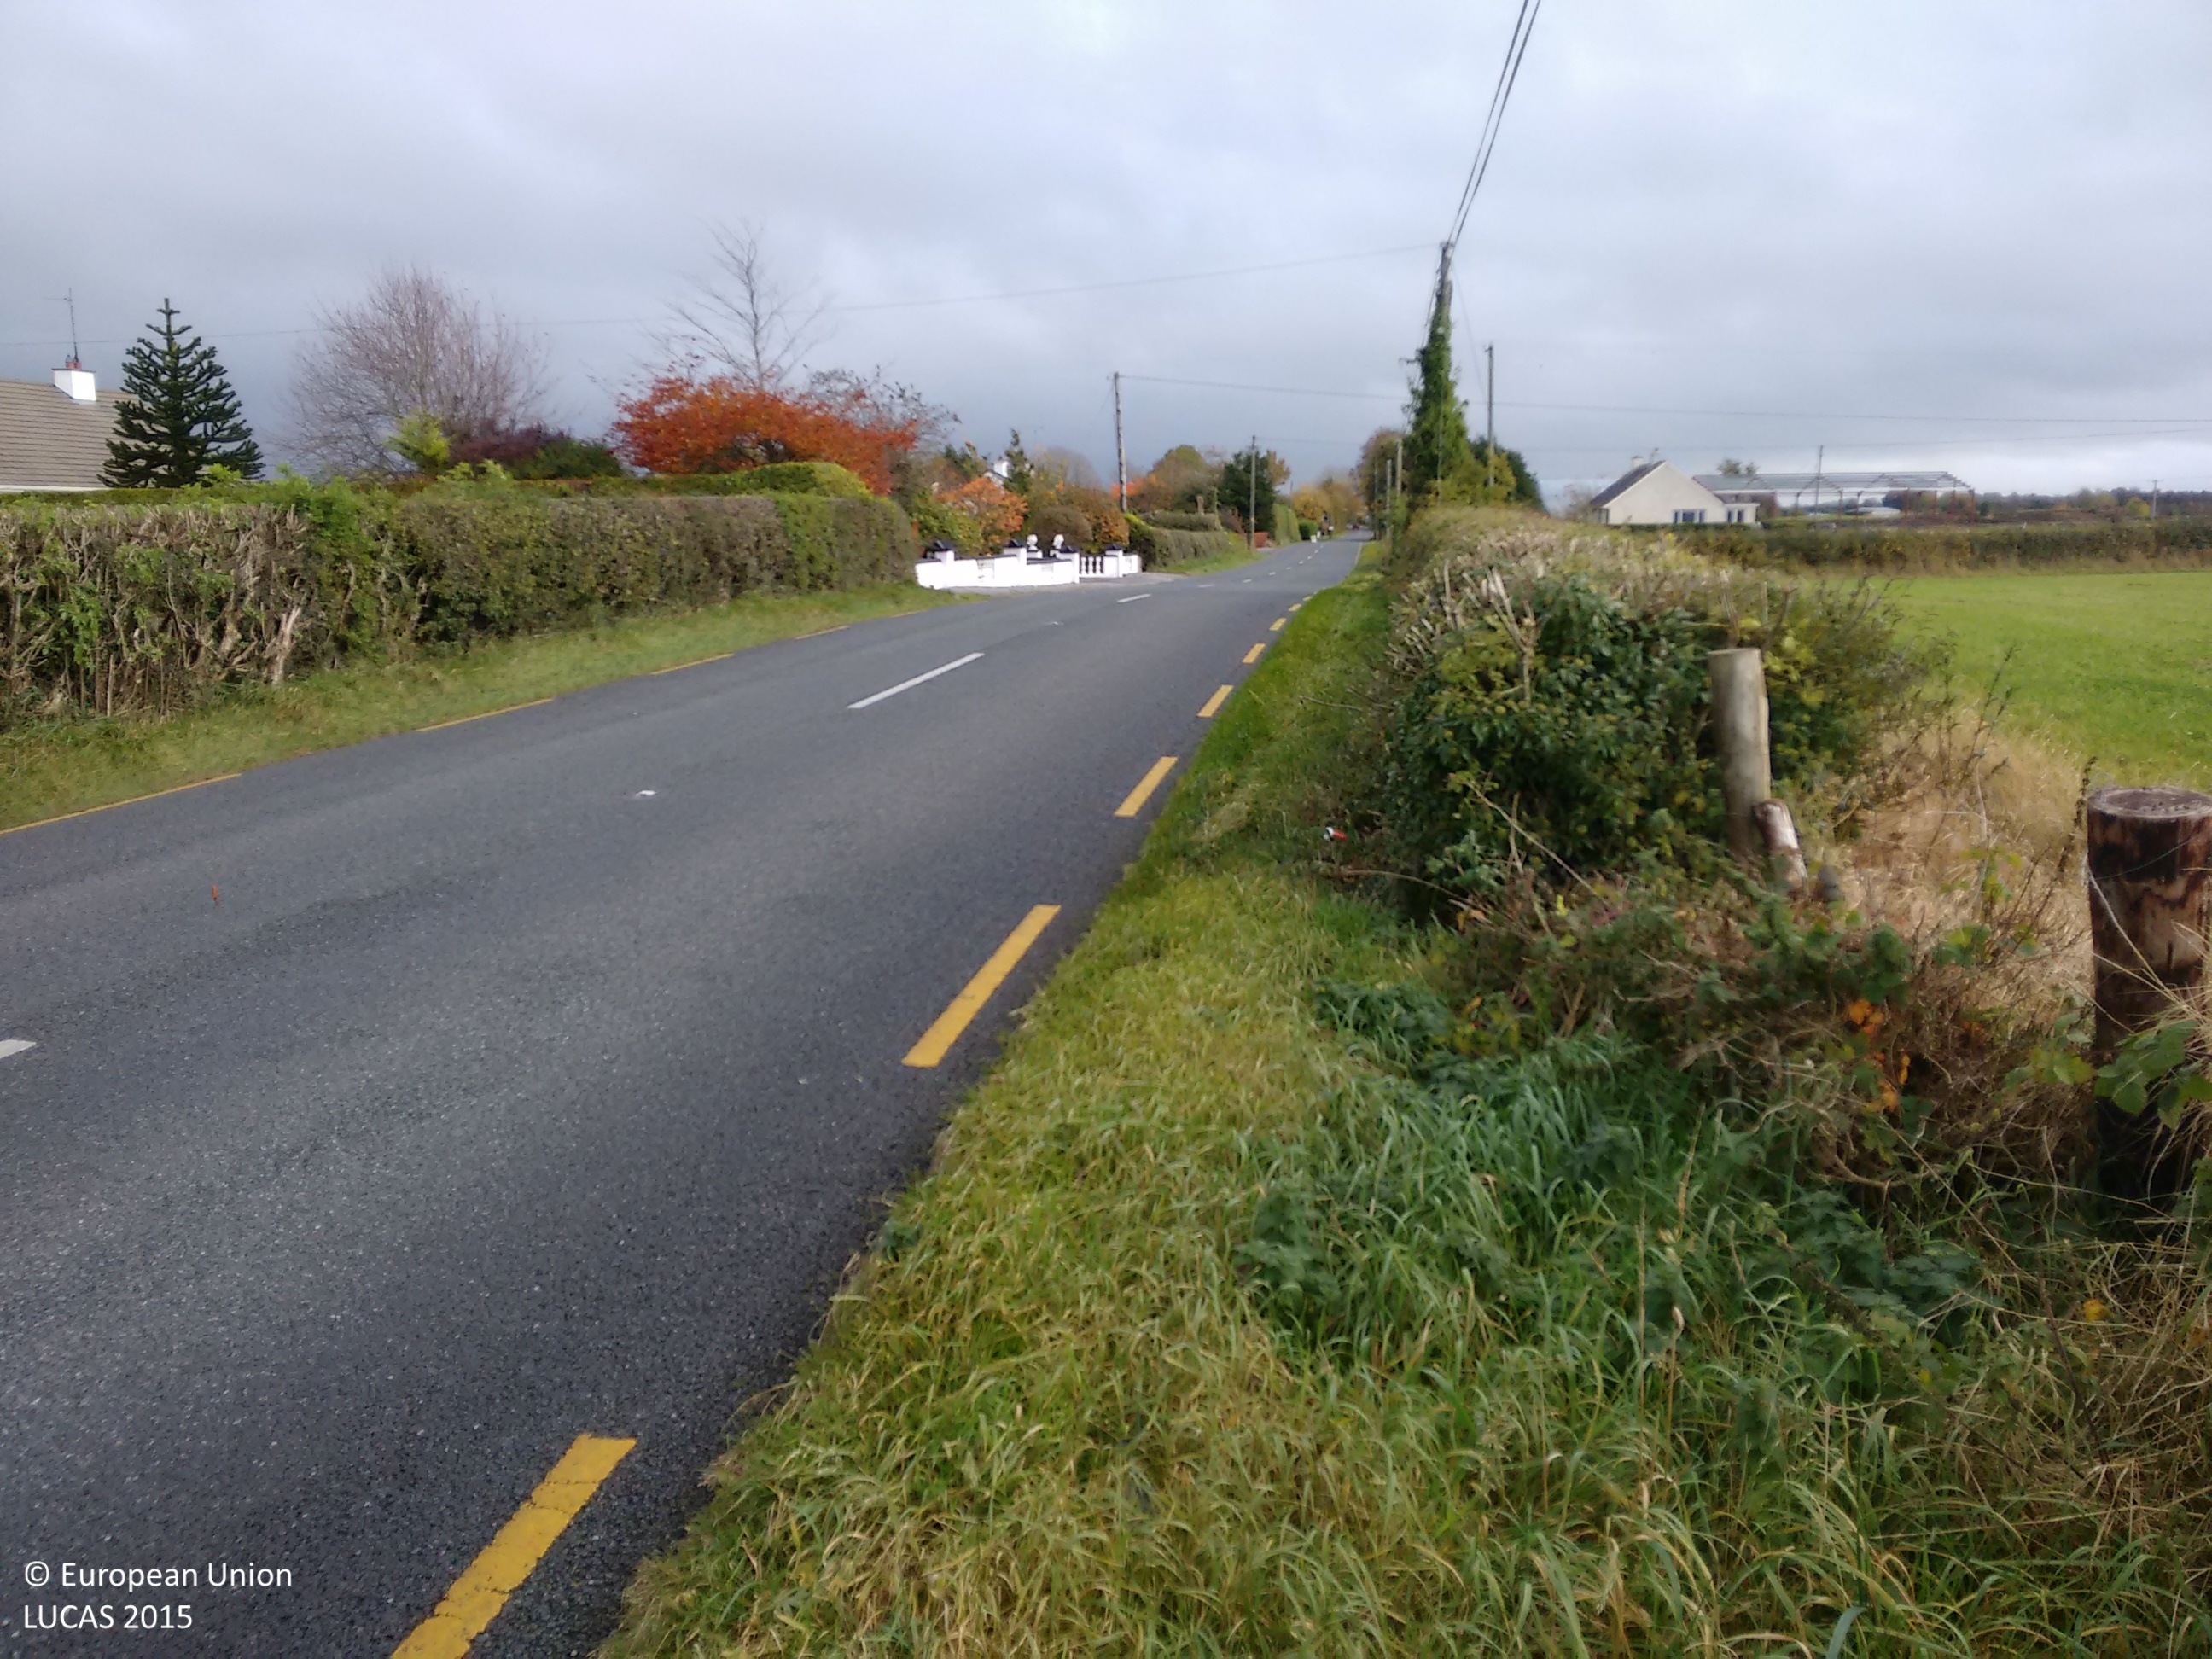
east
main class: Grassland
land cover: Grassland without tree/shrub cover
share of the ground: > 75 %
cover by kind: herbaceous plants 95 %, shrubs 5 %
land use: Agriculture (excluding fallow land and kitchen gardens)
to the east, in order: Grassland without tree/shrub cover; Electric lines; Grassland without tree/shrub cover; Managed hedges; Temporary grasslands; Managed hedges; Fences; Grassland without tree/shrub cover
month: October
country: IE
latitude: 53.2335
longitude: -7.6468
